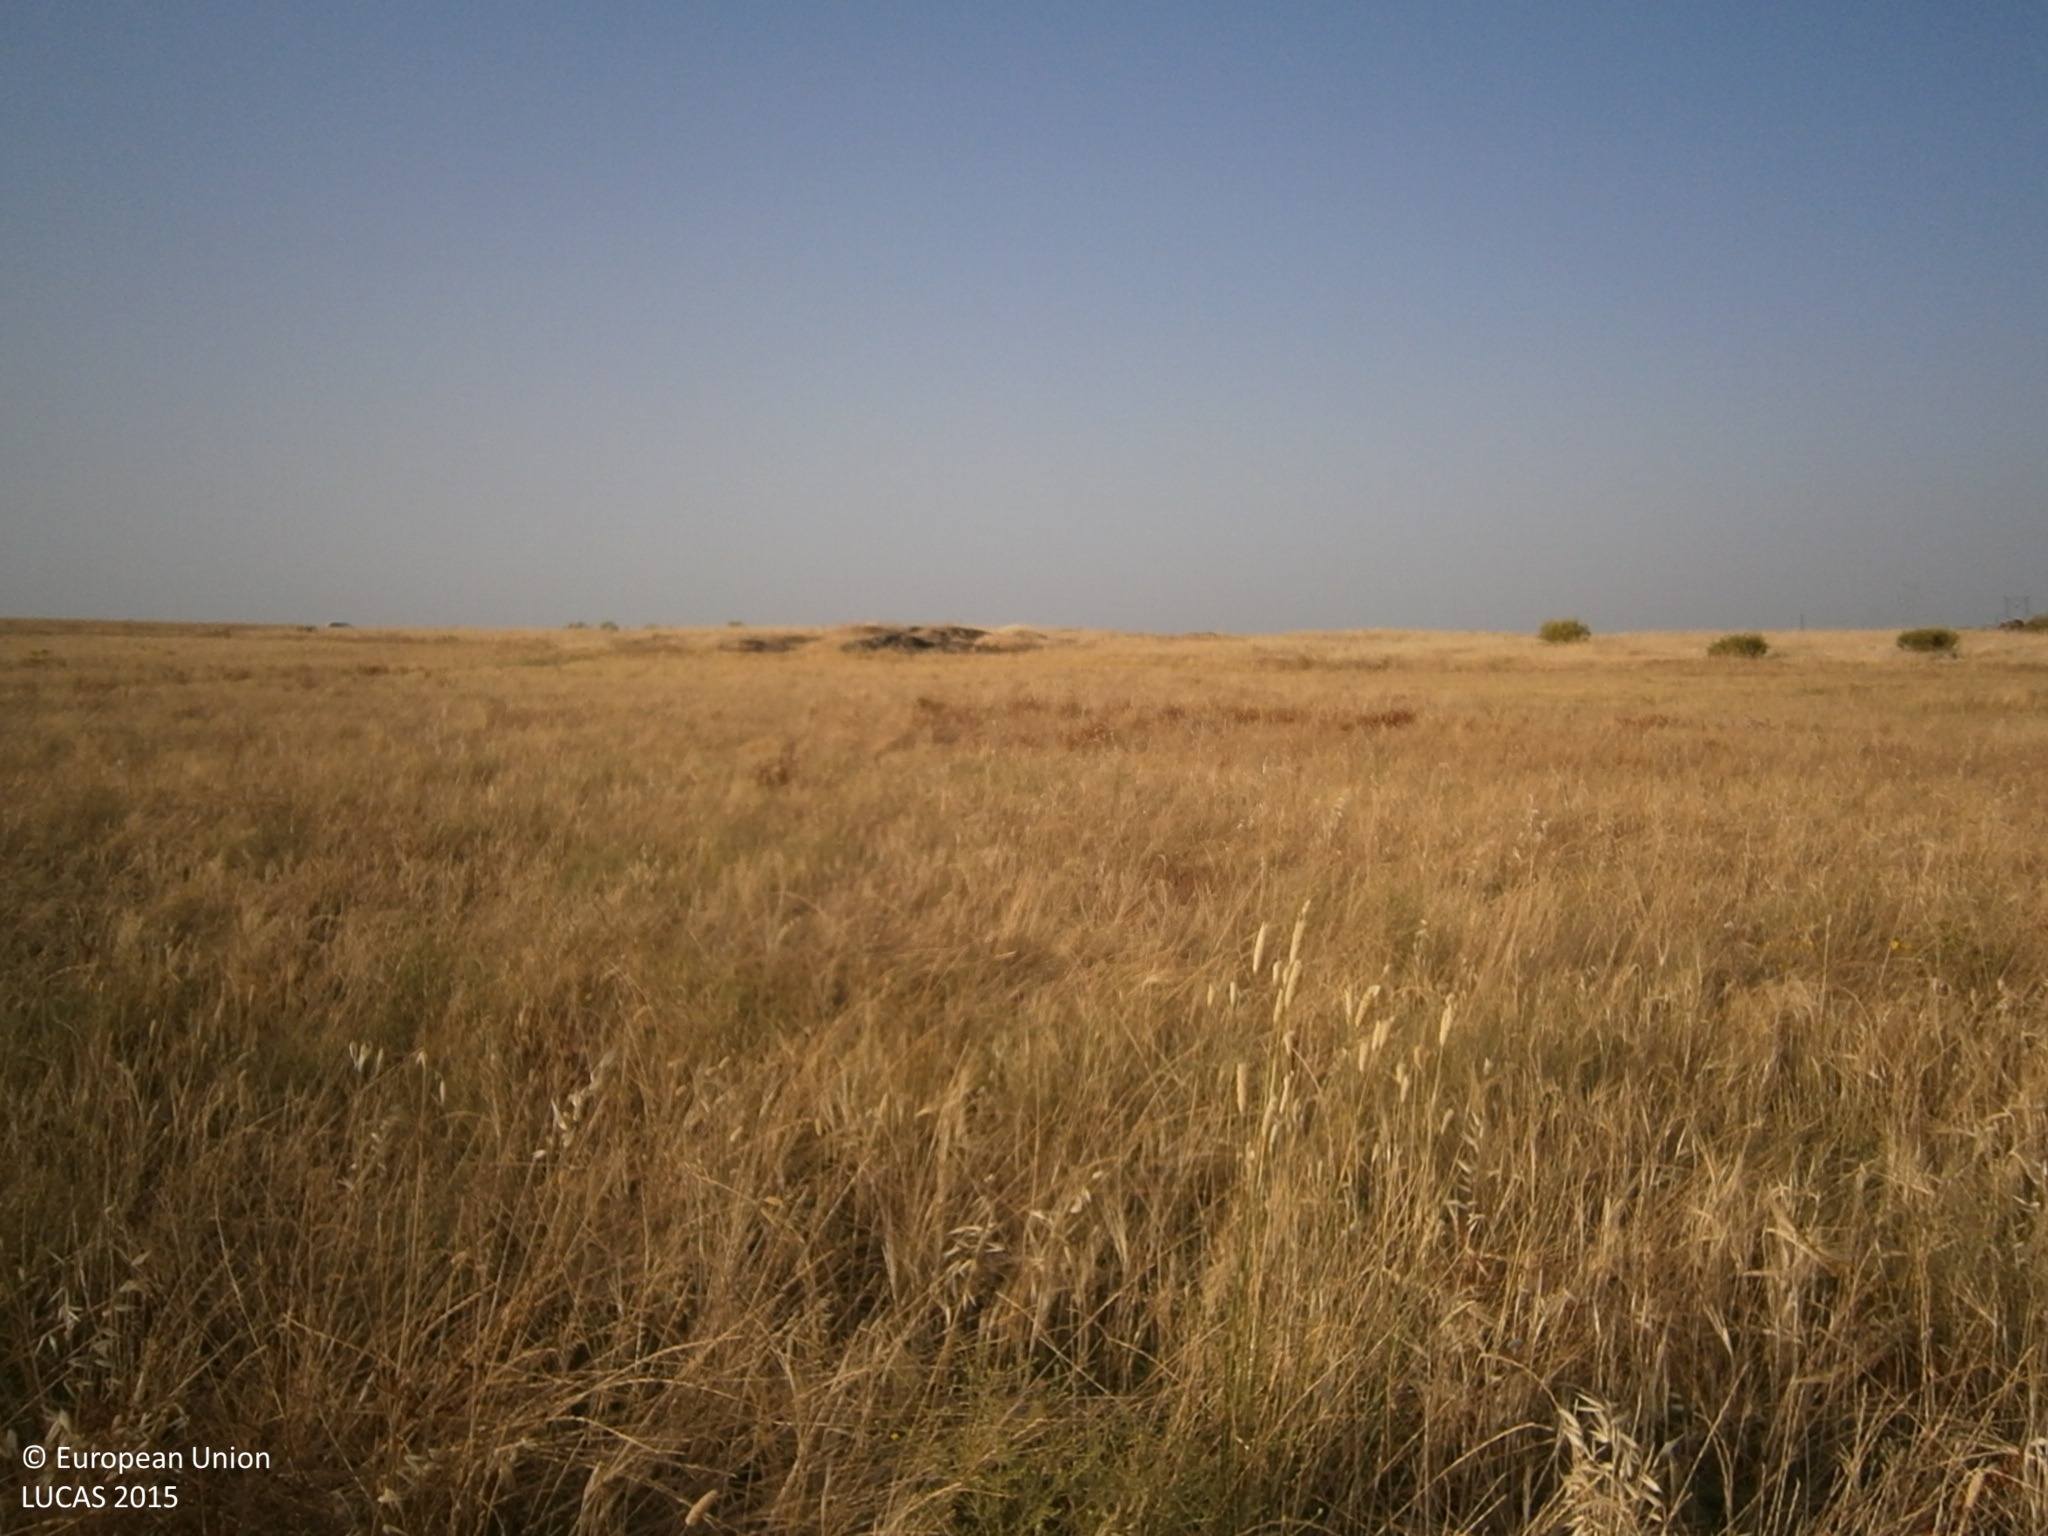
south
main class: Grassland
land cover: Grassland without tree/shrub cover
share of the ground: > 75 %
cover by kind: herbaceous plants 100 %
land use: Agriculture (excluding fallow land and kitchen gardens)
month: June
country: ES
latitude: 38.9013
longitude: -6.2563
